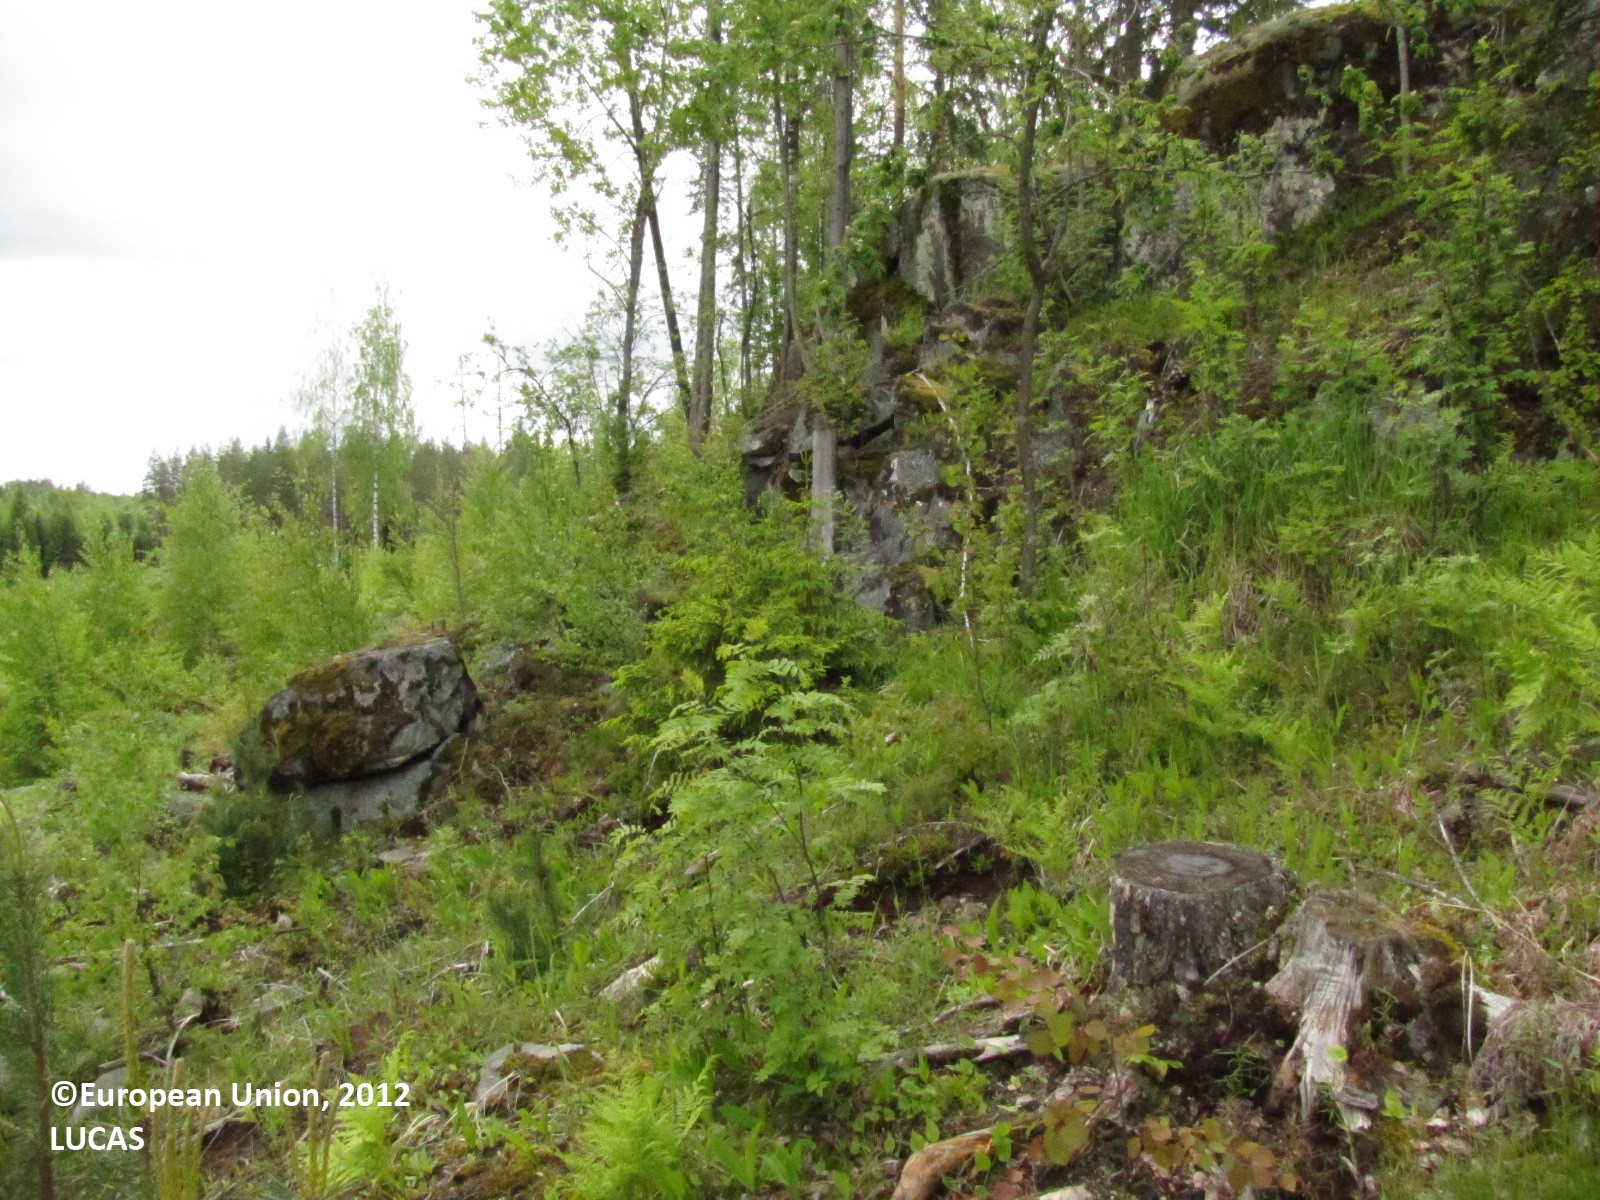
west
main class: Woodland
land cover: Broadleaved woodland
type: hemiboreal forest and nemoral coniferous forest and mixed broadleaved-coniferous forest
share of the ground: 50 - 75 %
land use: Forestry
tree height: < 5 m
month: June
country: FI
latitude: 61.5272
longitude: 23.0648
